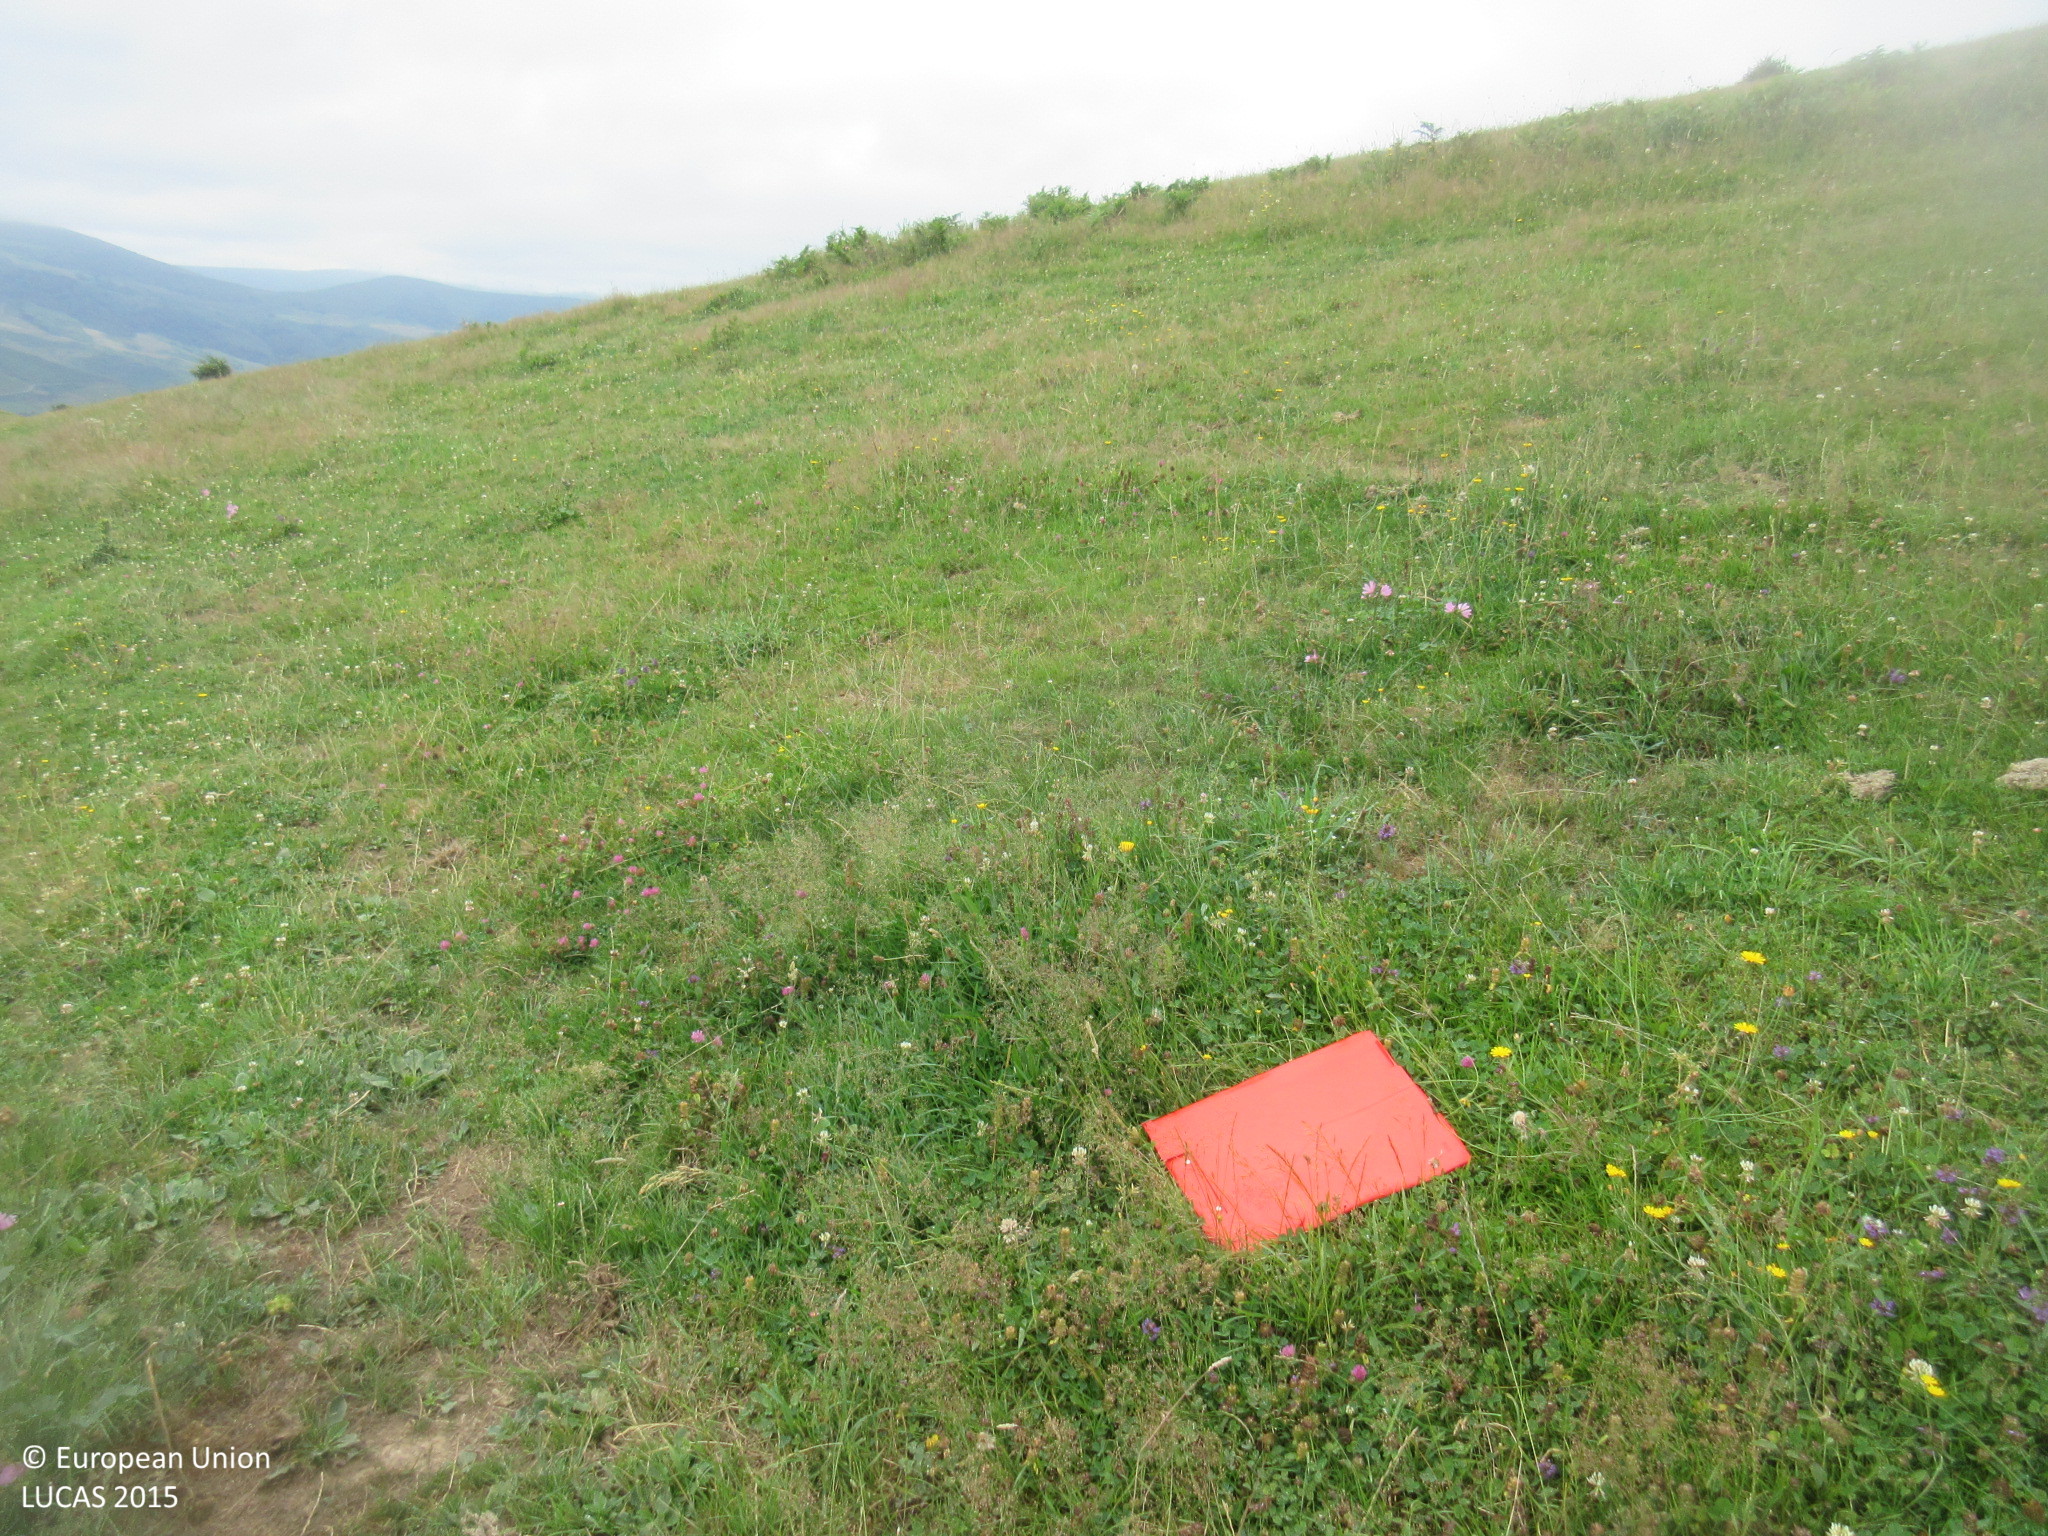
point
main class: Grassland
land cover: Grassland without tree/shrub cover
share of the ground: > 75 %
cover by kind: herbaceous plants 100 %
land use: Agriculture (excluding fallow land and kitchen gardens)
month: July
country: ES
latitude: 43.2054
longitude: -3.5192
